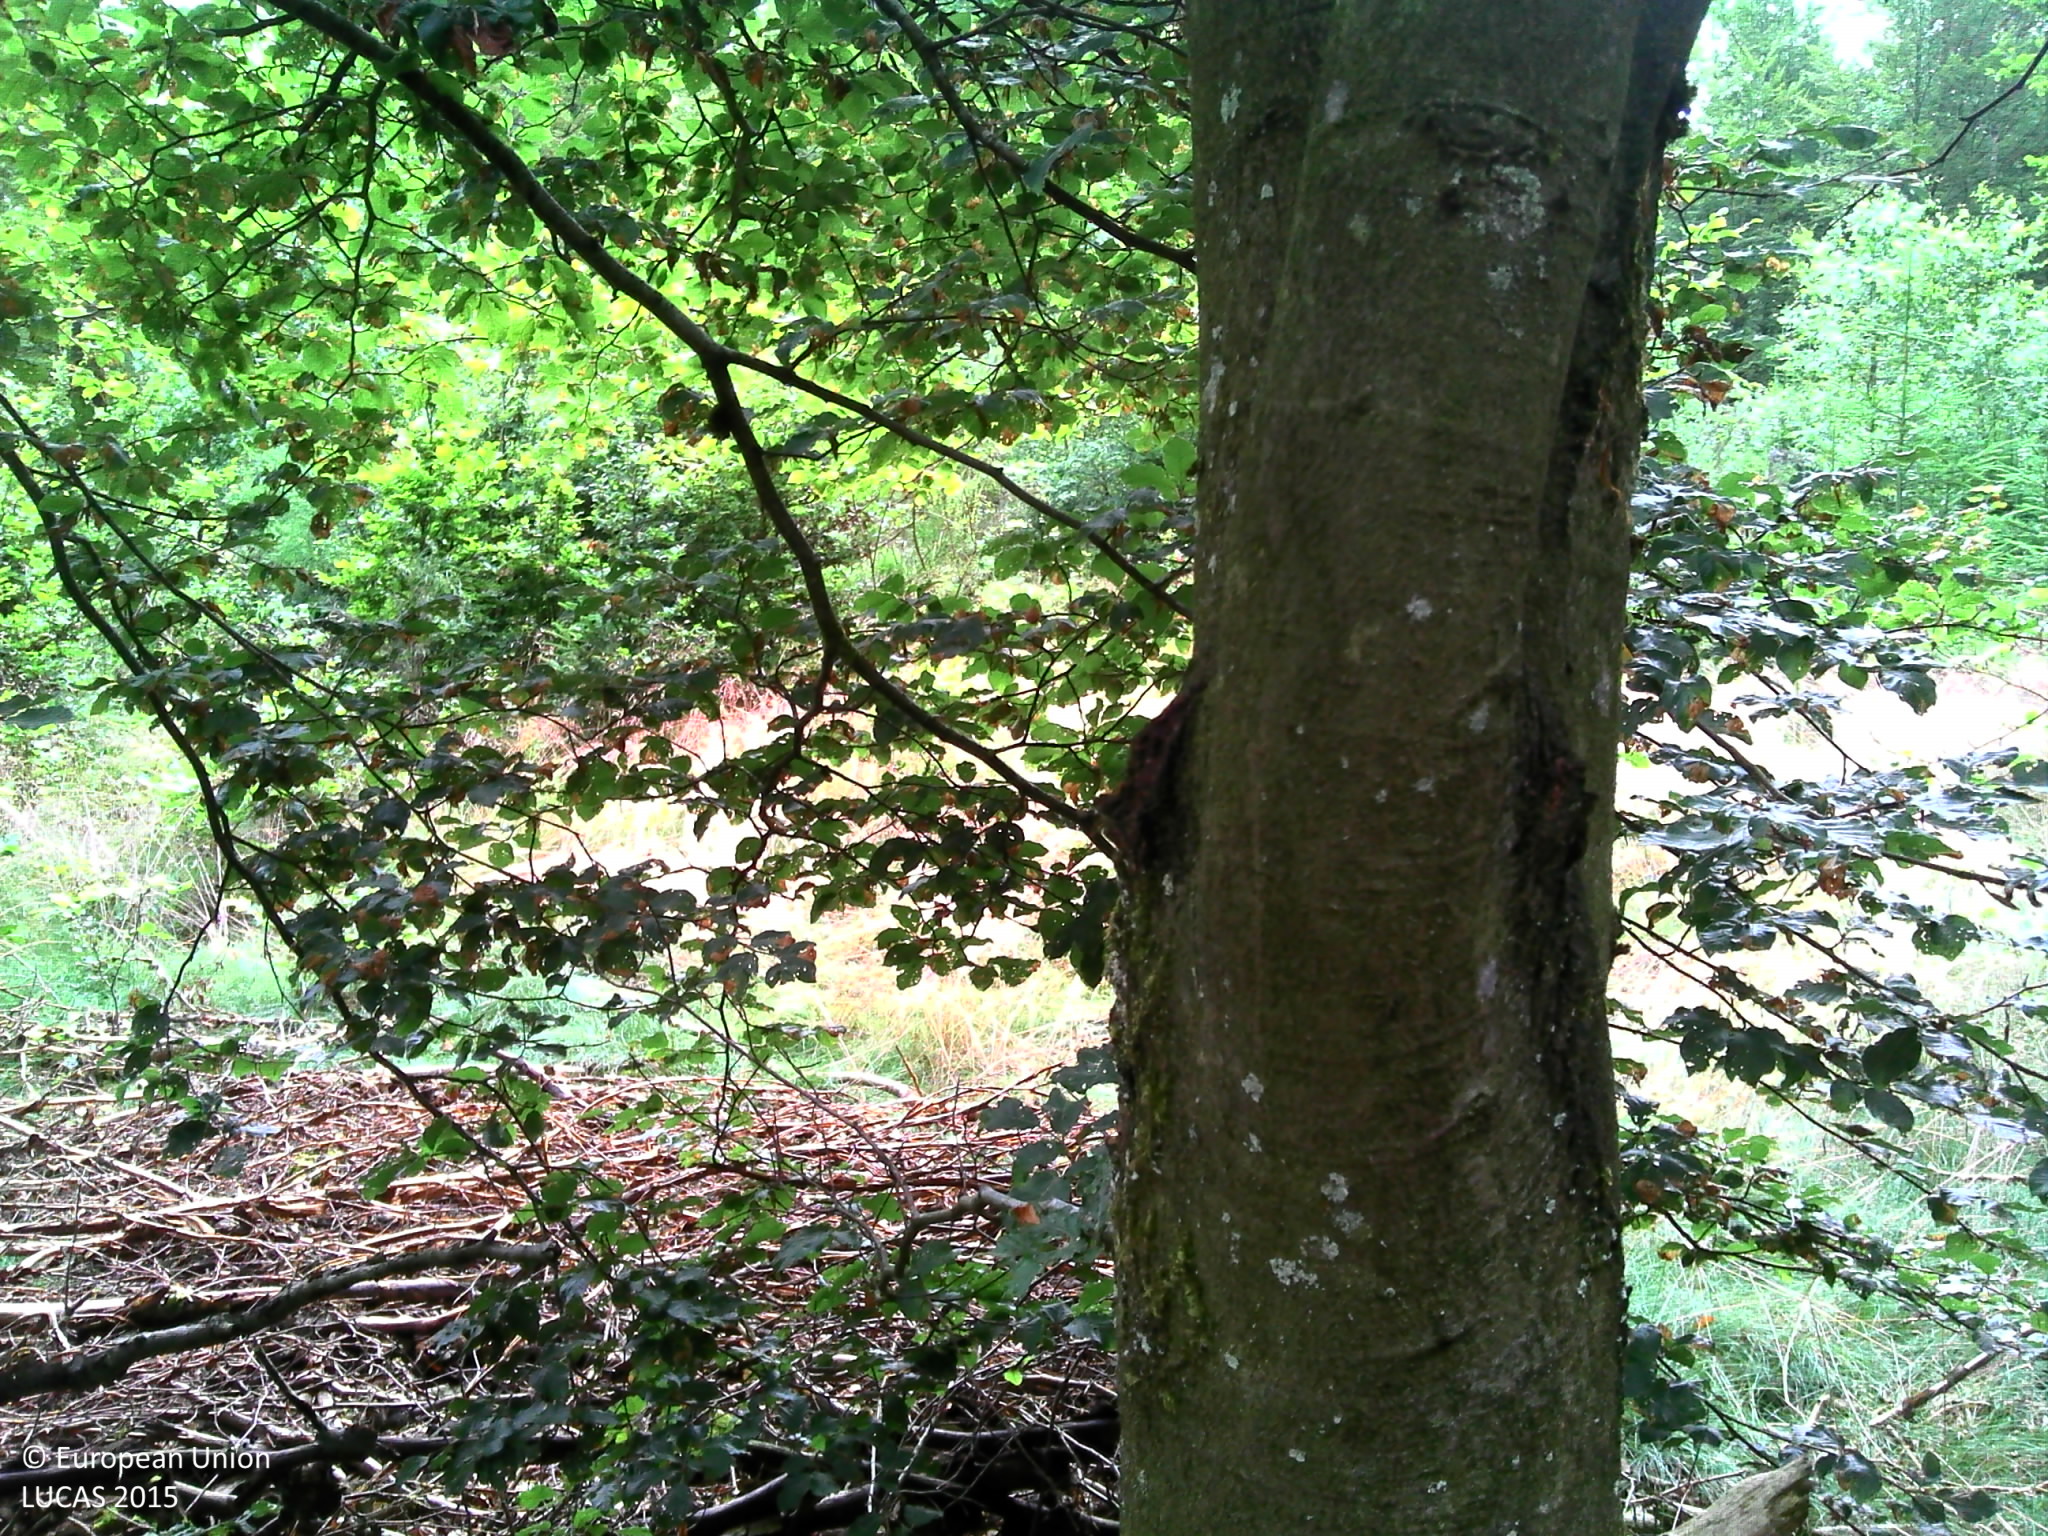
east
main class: Woodland
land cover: Broadleaved woodland
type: beech forest
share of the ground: 50 - 75 %
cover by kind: broadleaved forest trees 50 %, unconsolidated bare surface 25 %, herbaceous plants 20 %, coniferous forest trees 5 %
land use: Forestry
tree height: > 5 m
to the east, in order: Broadleaved woodland; Shrubland with sparse tree cover; Tracks; Broadleaved woodland; Ditches and canals; Broadleaved woodland; Spruce dominated coniferous woodland; Broadleaved woodland
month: July
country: BE
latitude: 49.7662
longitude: 5.3749
